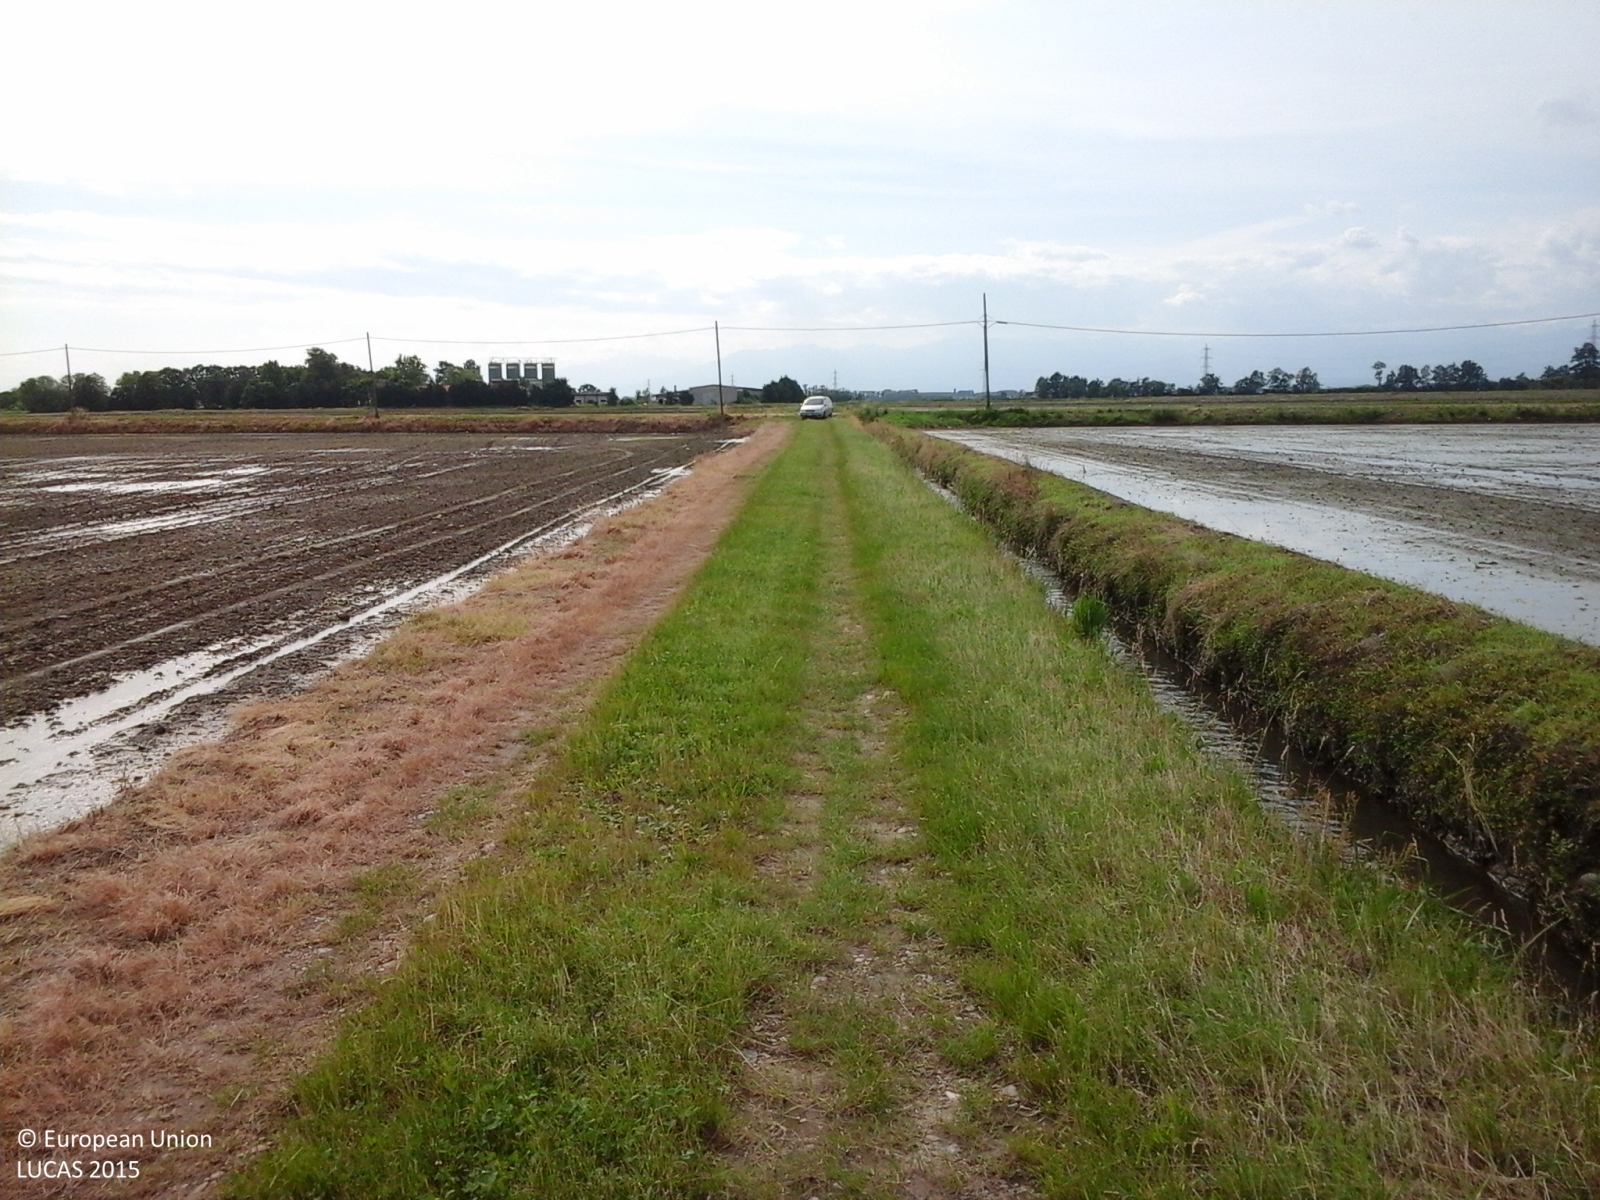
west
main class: Cropland
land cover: Rice
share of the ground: < 10 %
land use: Agriculture (excluding fallow land and kitchen gardens)
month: May
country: IT
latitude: 45.4765
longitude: 8.5569
